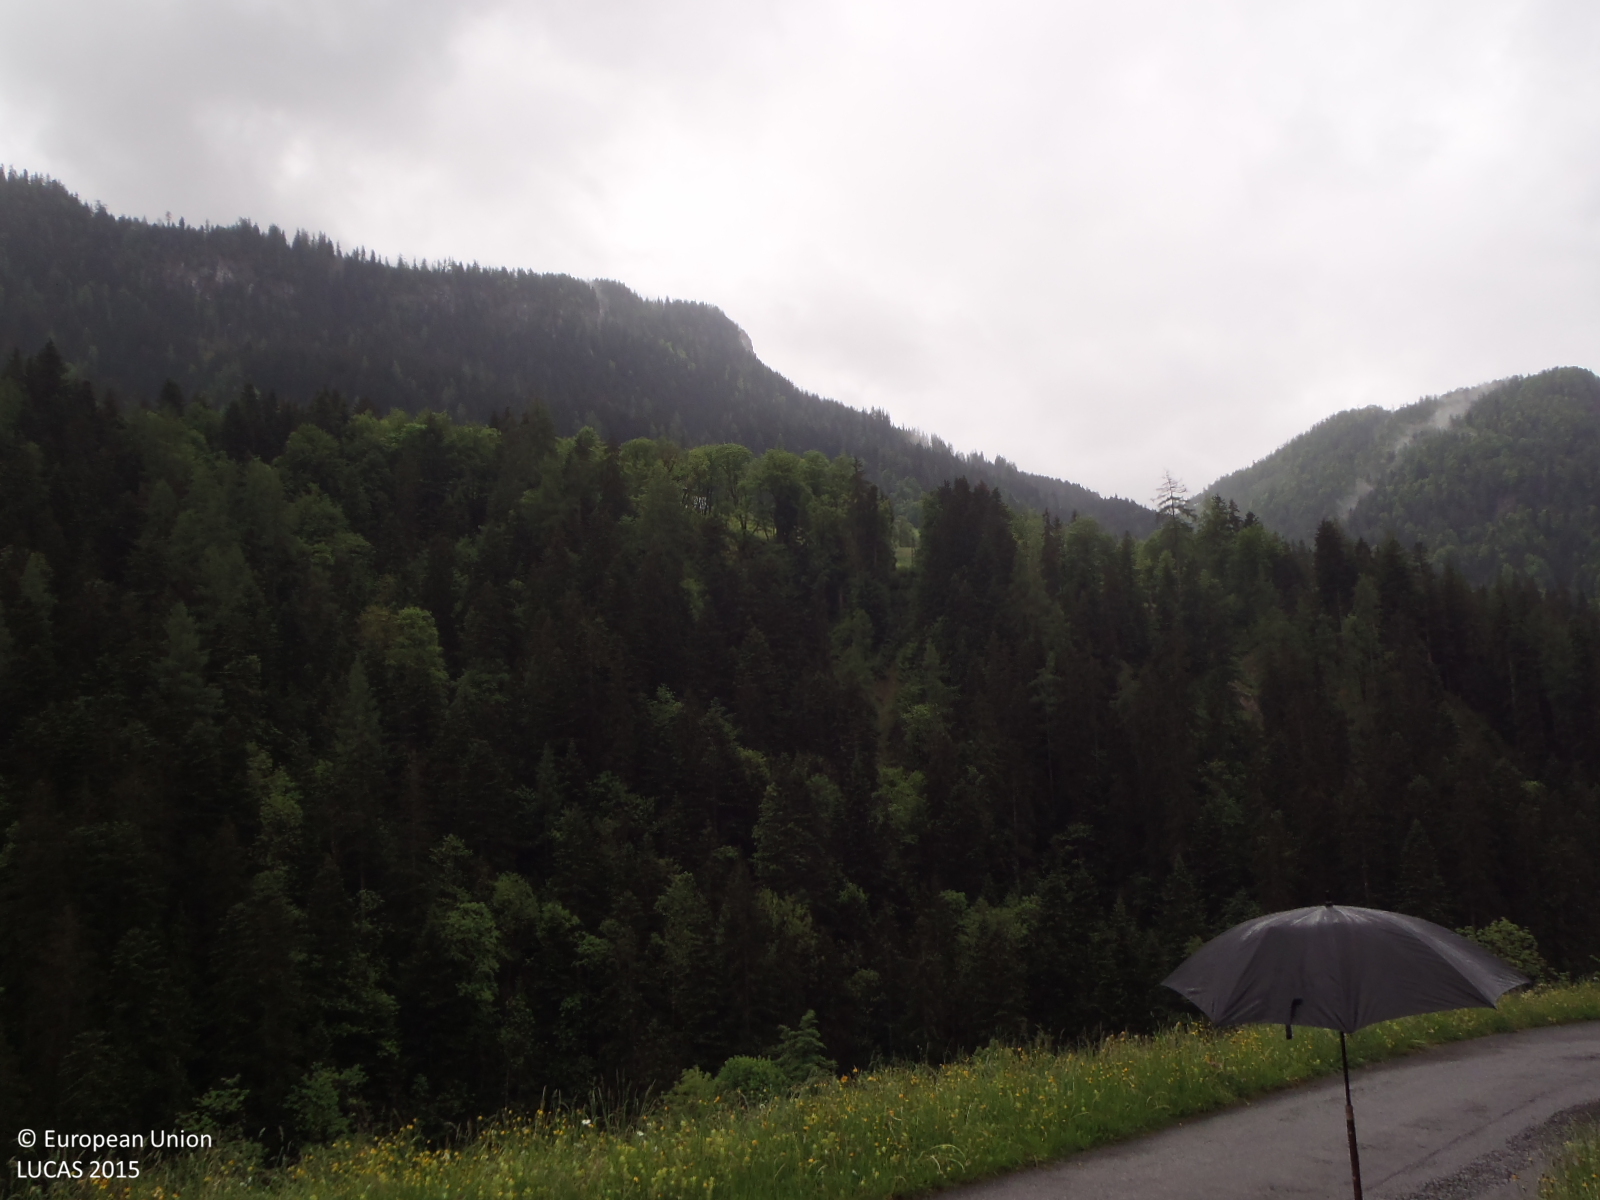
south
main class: Grassland
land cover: Grassland without tree/shrub cover
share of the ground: > 75 %
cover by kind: herbaceous plants 100 %
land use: Agriculture (excluding fallow land and kitchen gardens)
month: May
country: AT
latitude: 47.5590
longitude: 12.7494
